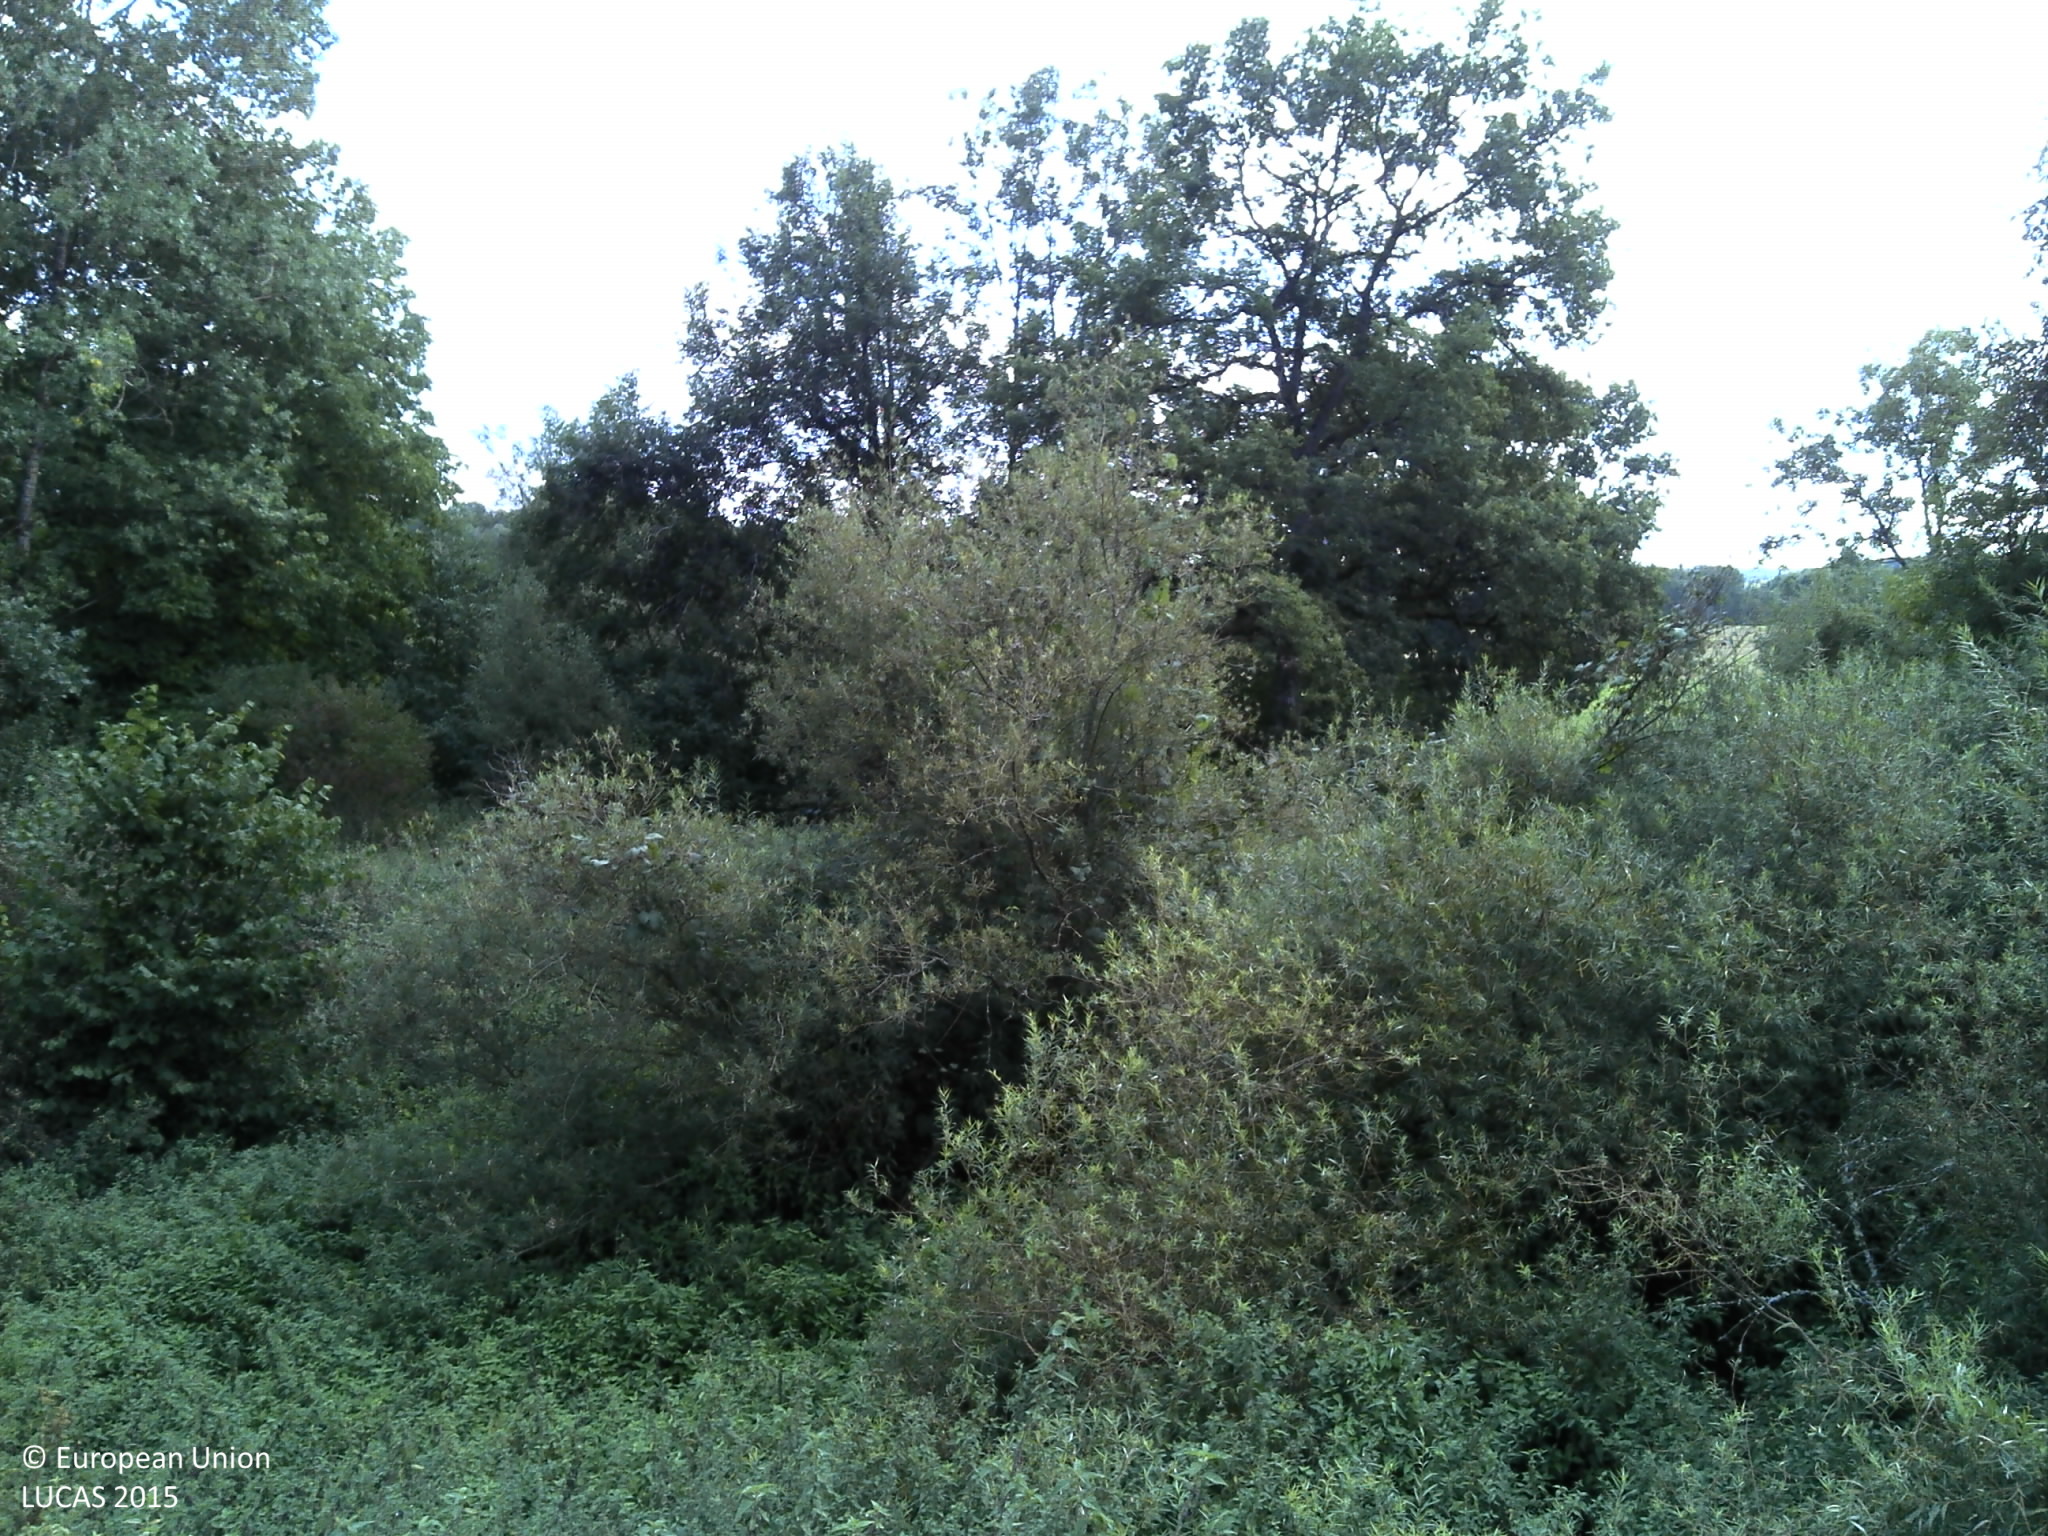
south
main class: Woodland
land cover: Broadleaved woodland
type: floodplain forest
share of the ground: 50 - 75 %
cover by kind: broadleaved forest trees 55 %, herbaceous plants 35 %, shrubs 10 %
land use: Semi-natural and natural areas not in use
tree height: > 5 m
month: September
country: FR
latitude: 48.0474
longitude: 5.2104
